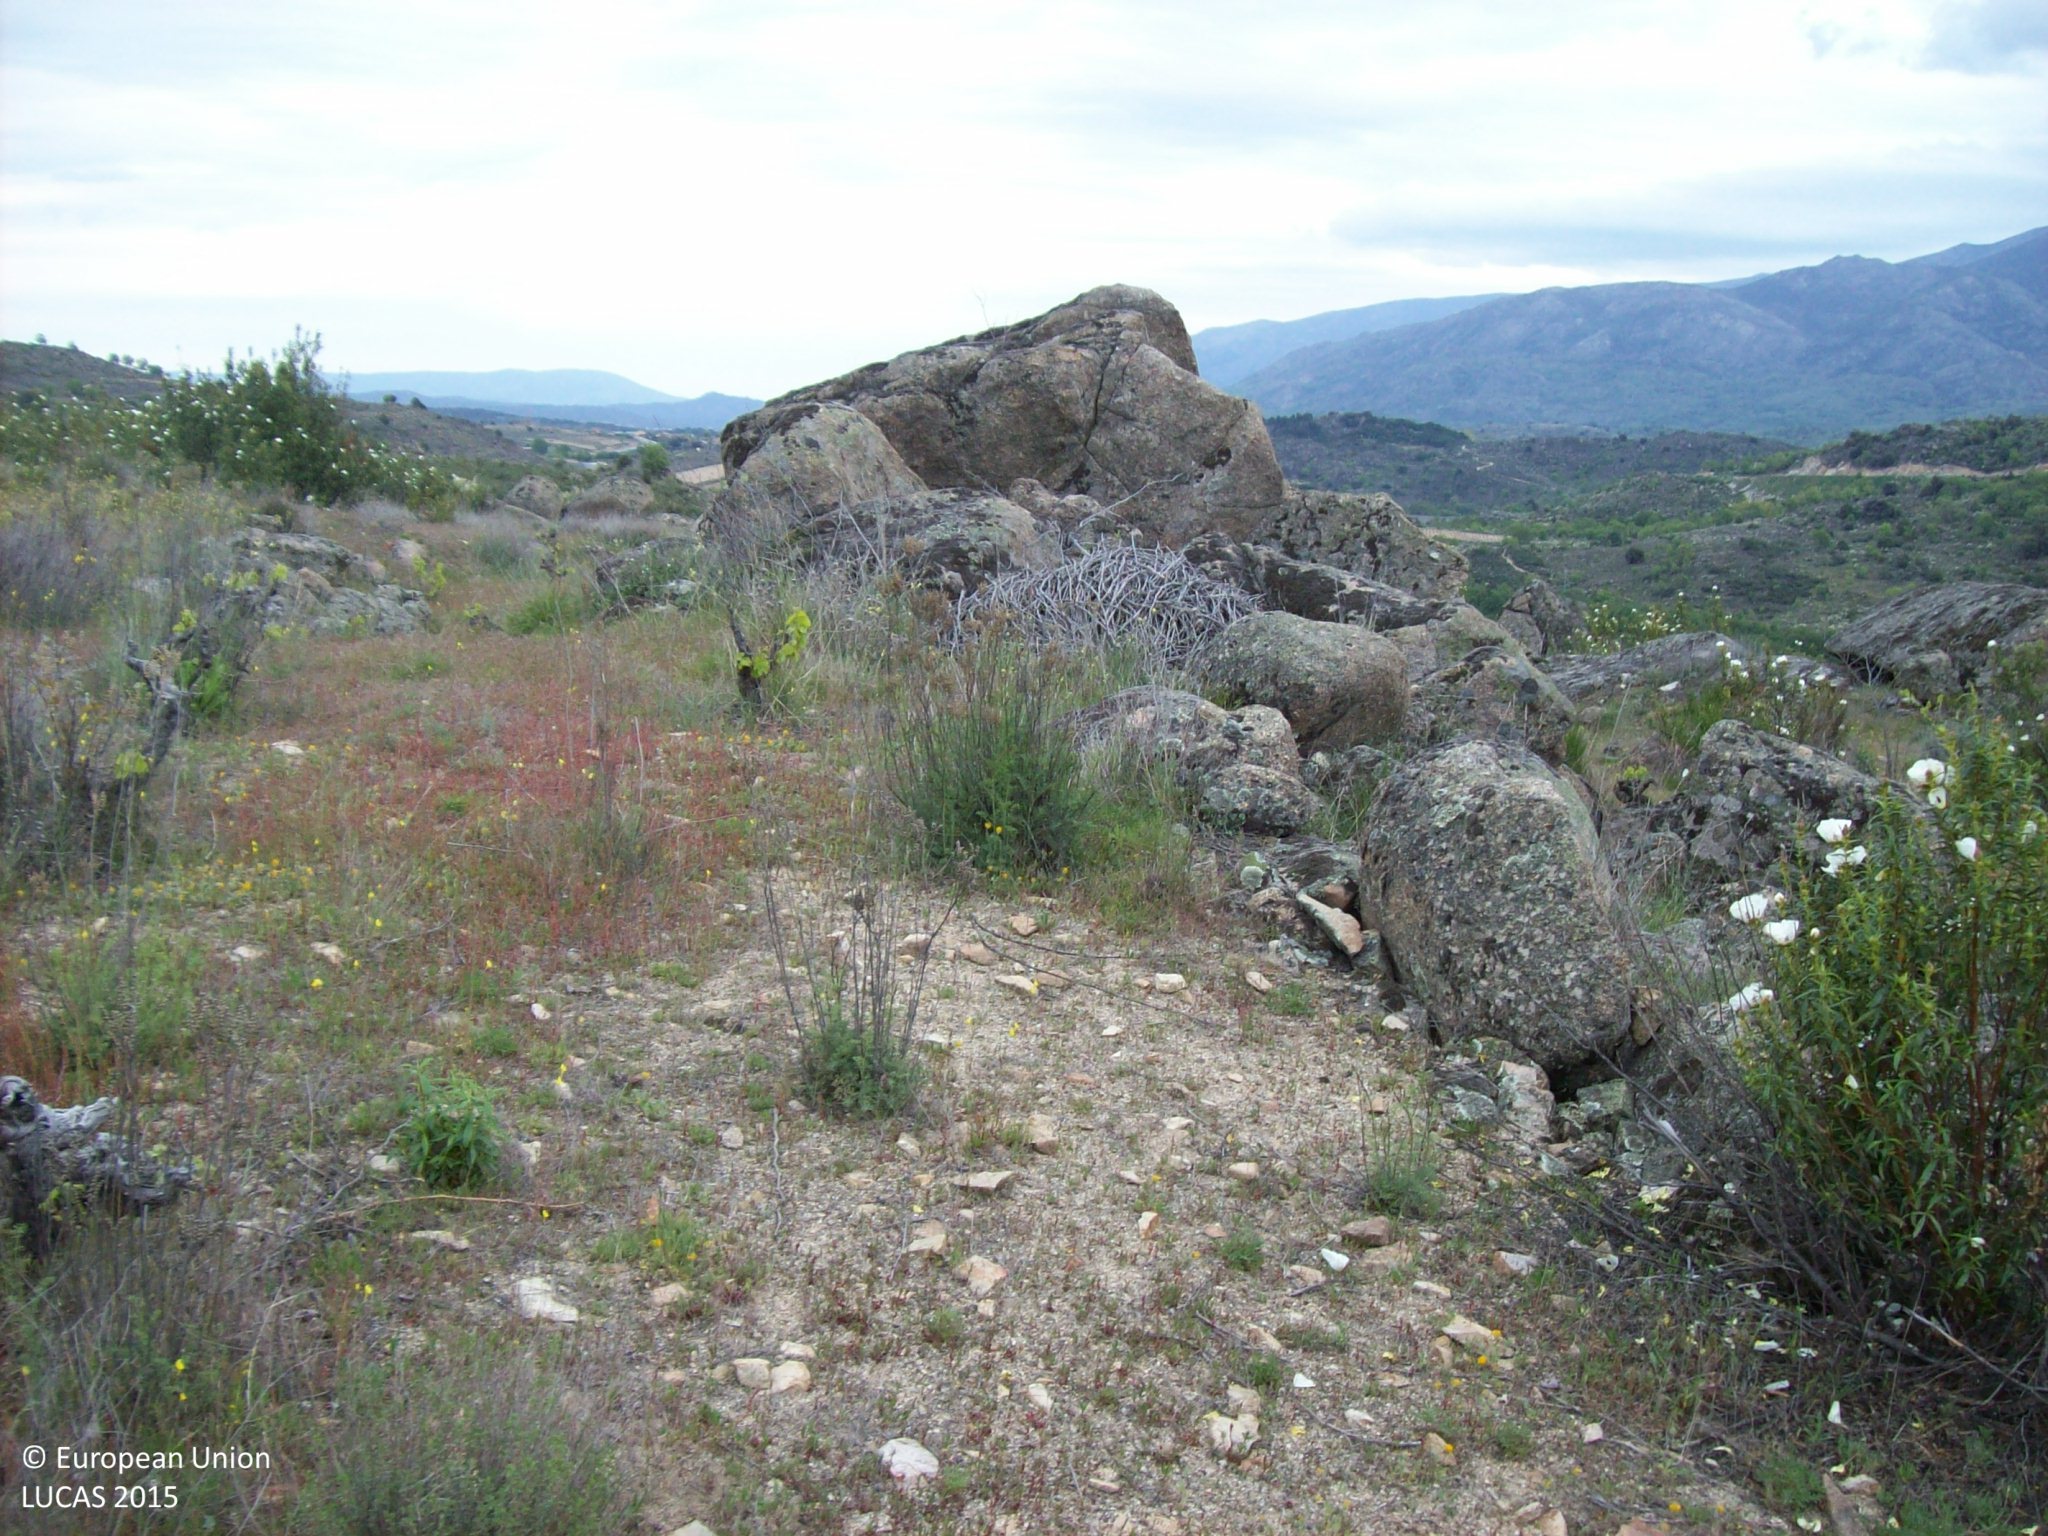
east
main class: Cropland
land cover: Vineyards
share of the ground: 10 - 25 %
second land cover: Shrubland without tree cover
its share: 25 - 50 %
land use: Abandoned areas
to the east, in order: Vineyards; Shrubland without tree cover; Rock outcrops; Vineyards; Rock outcrops; Shrubland without tree cover; Dry stone walls; Broadleaved woodland; Dry stone walls; Fences; Rock outcrops; Shrubland without tree cover
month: April
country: ES
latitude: 40.4018
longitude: -4.8175
